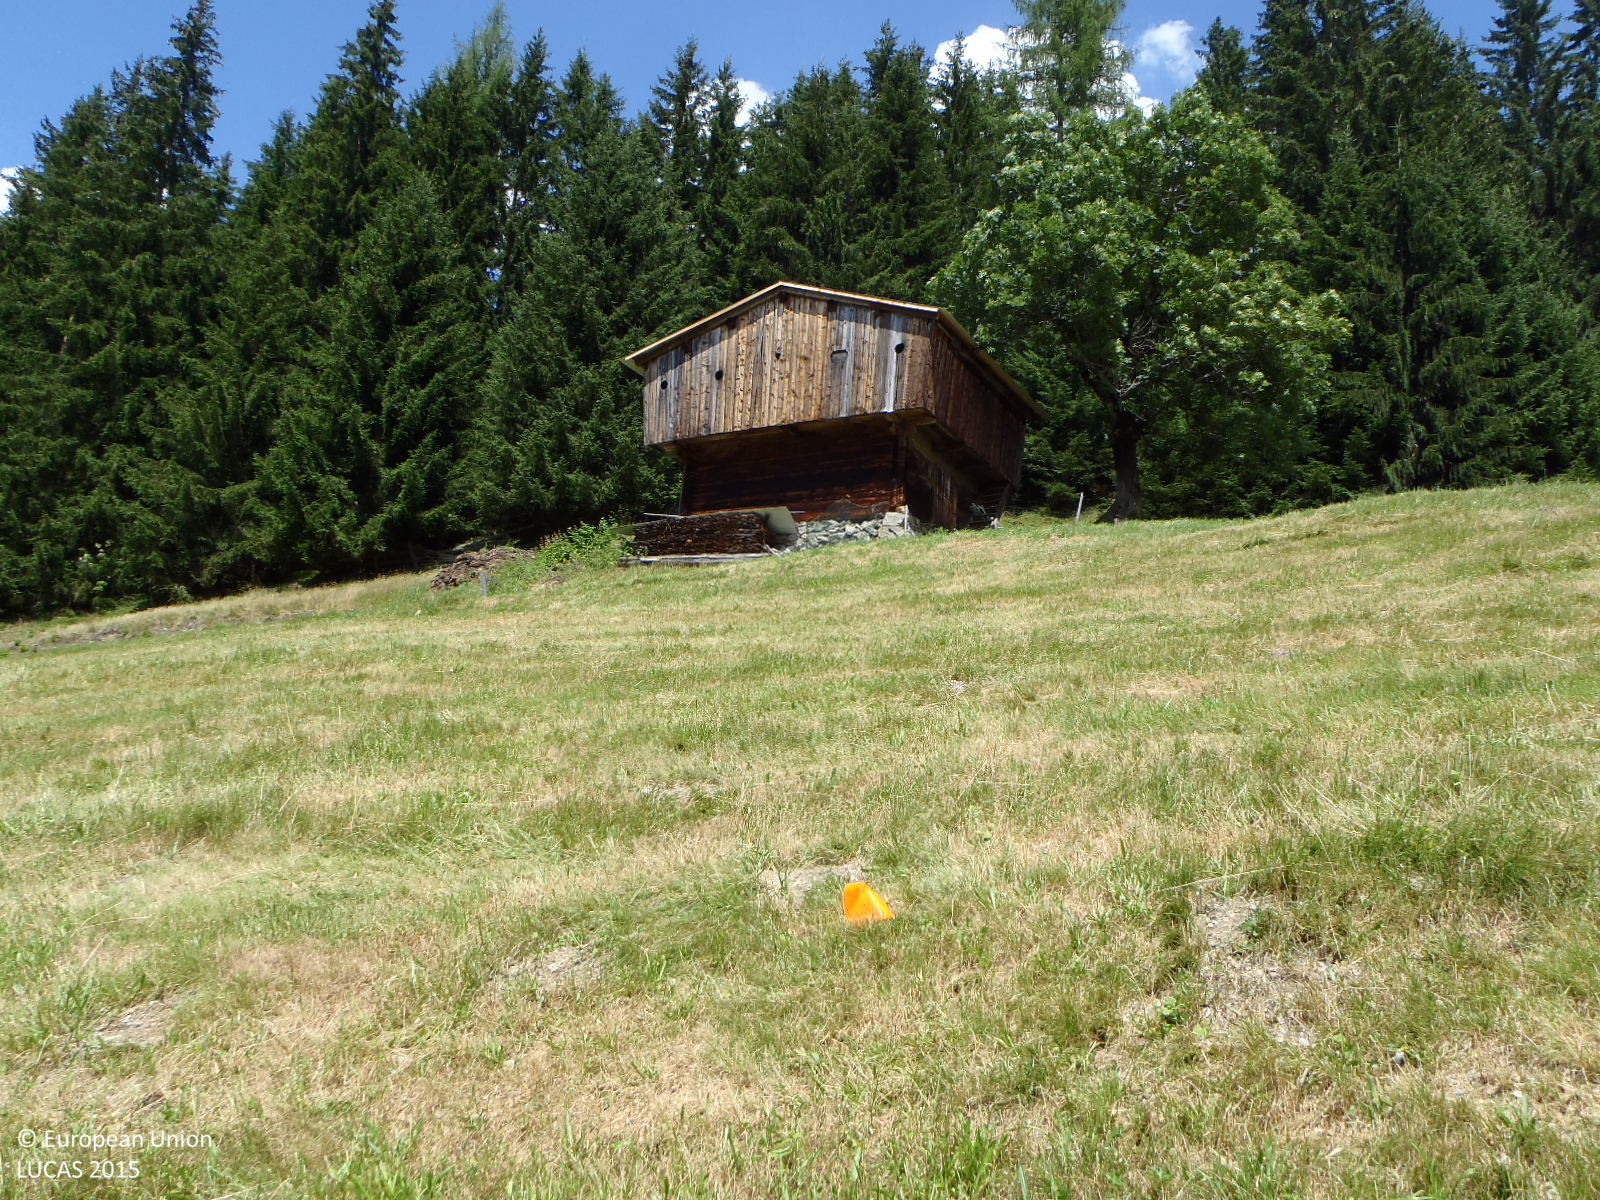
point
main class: Grassland
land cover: Grassland without tree/shrub cover
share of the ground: > 75 %
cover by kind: herbaceous plants 100 %
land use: Agriculture (excluding fallow land and kitchen gardens)
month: July
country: AT
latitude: 47.3777
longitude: 11.9719
